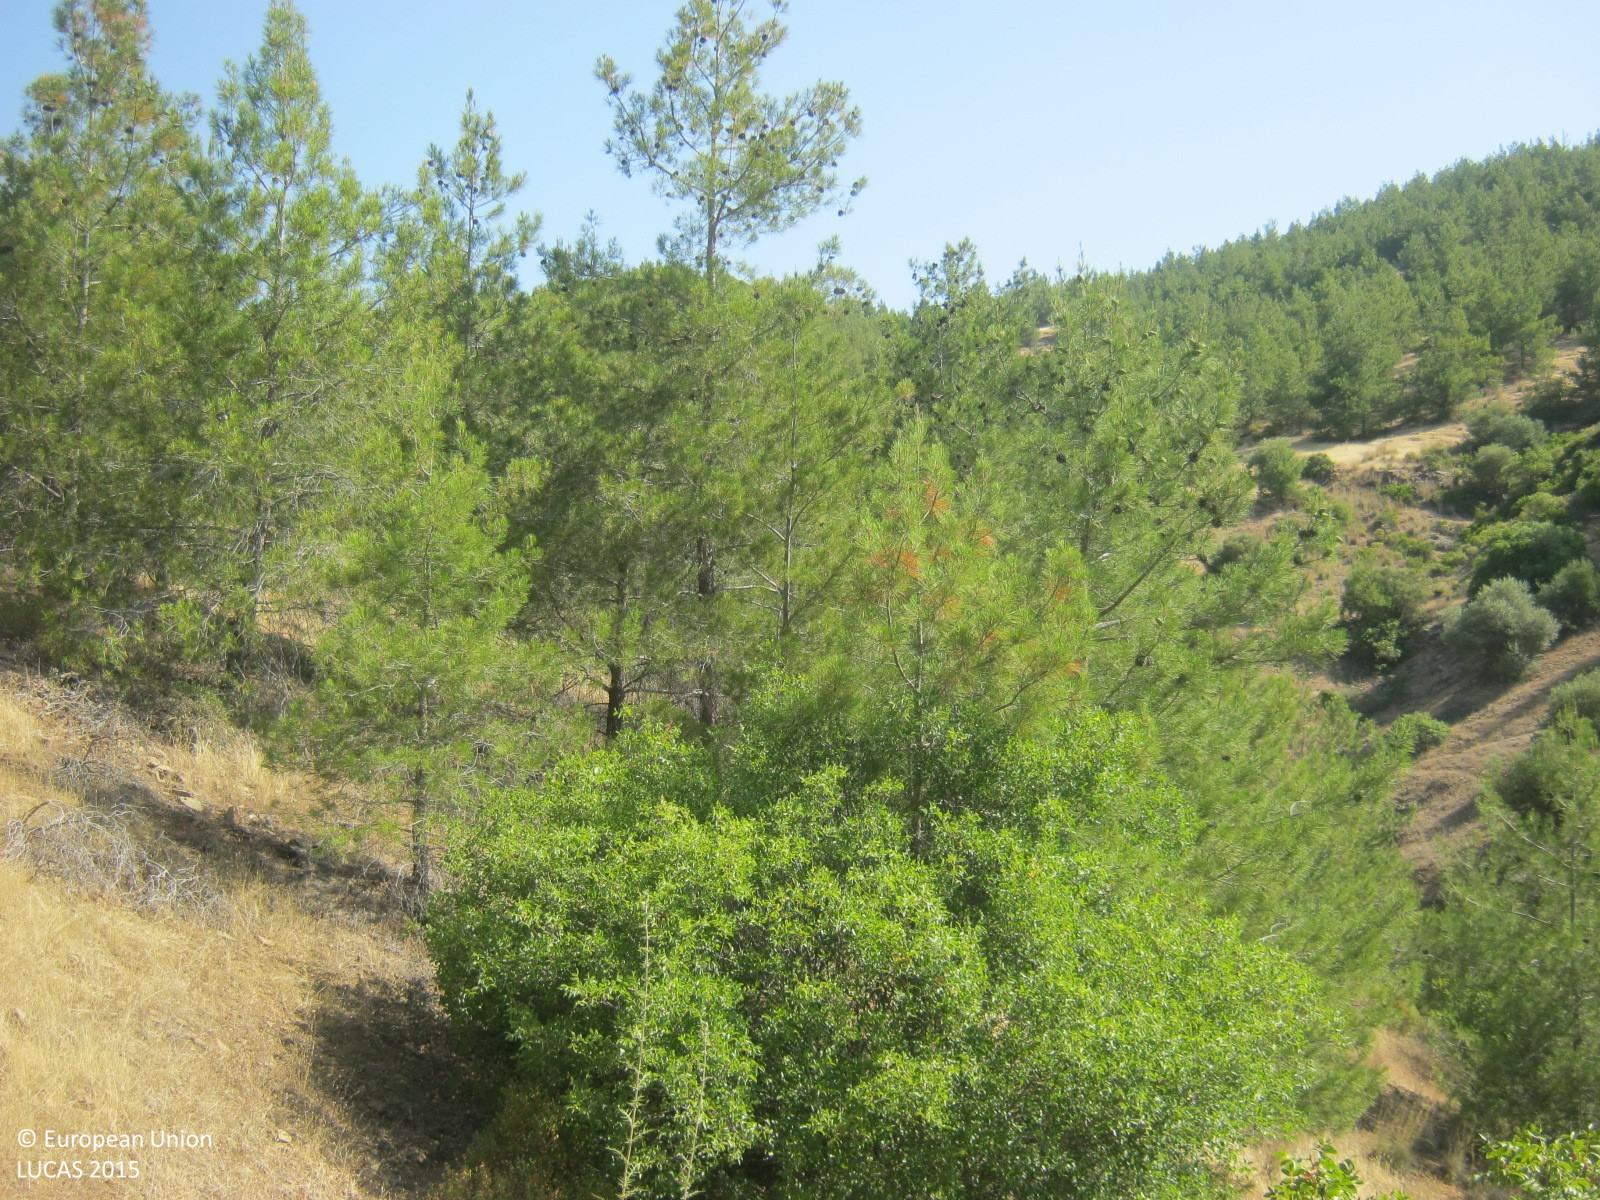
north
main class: Woodland
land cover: Pine dominated coniferous woodland
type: coniferous forest of the mediterranean region
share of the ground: 50 - 75 %
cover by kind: coniferous forest trees 60 %, shrubs 15 %, herbaceous plants 10 %, unconsolidated bare surface 10 %, broadleaved forest trees 5 %
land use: Forestry
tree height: > 5 m
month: June
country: CY
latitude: 35.0410
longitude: 32.9871
